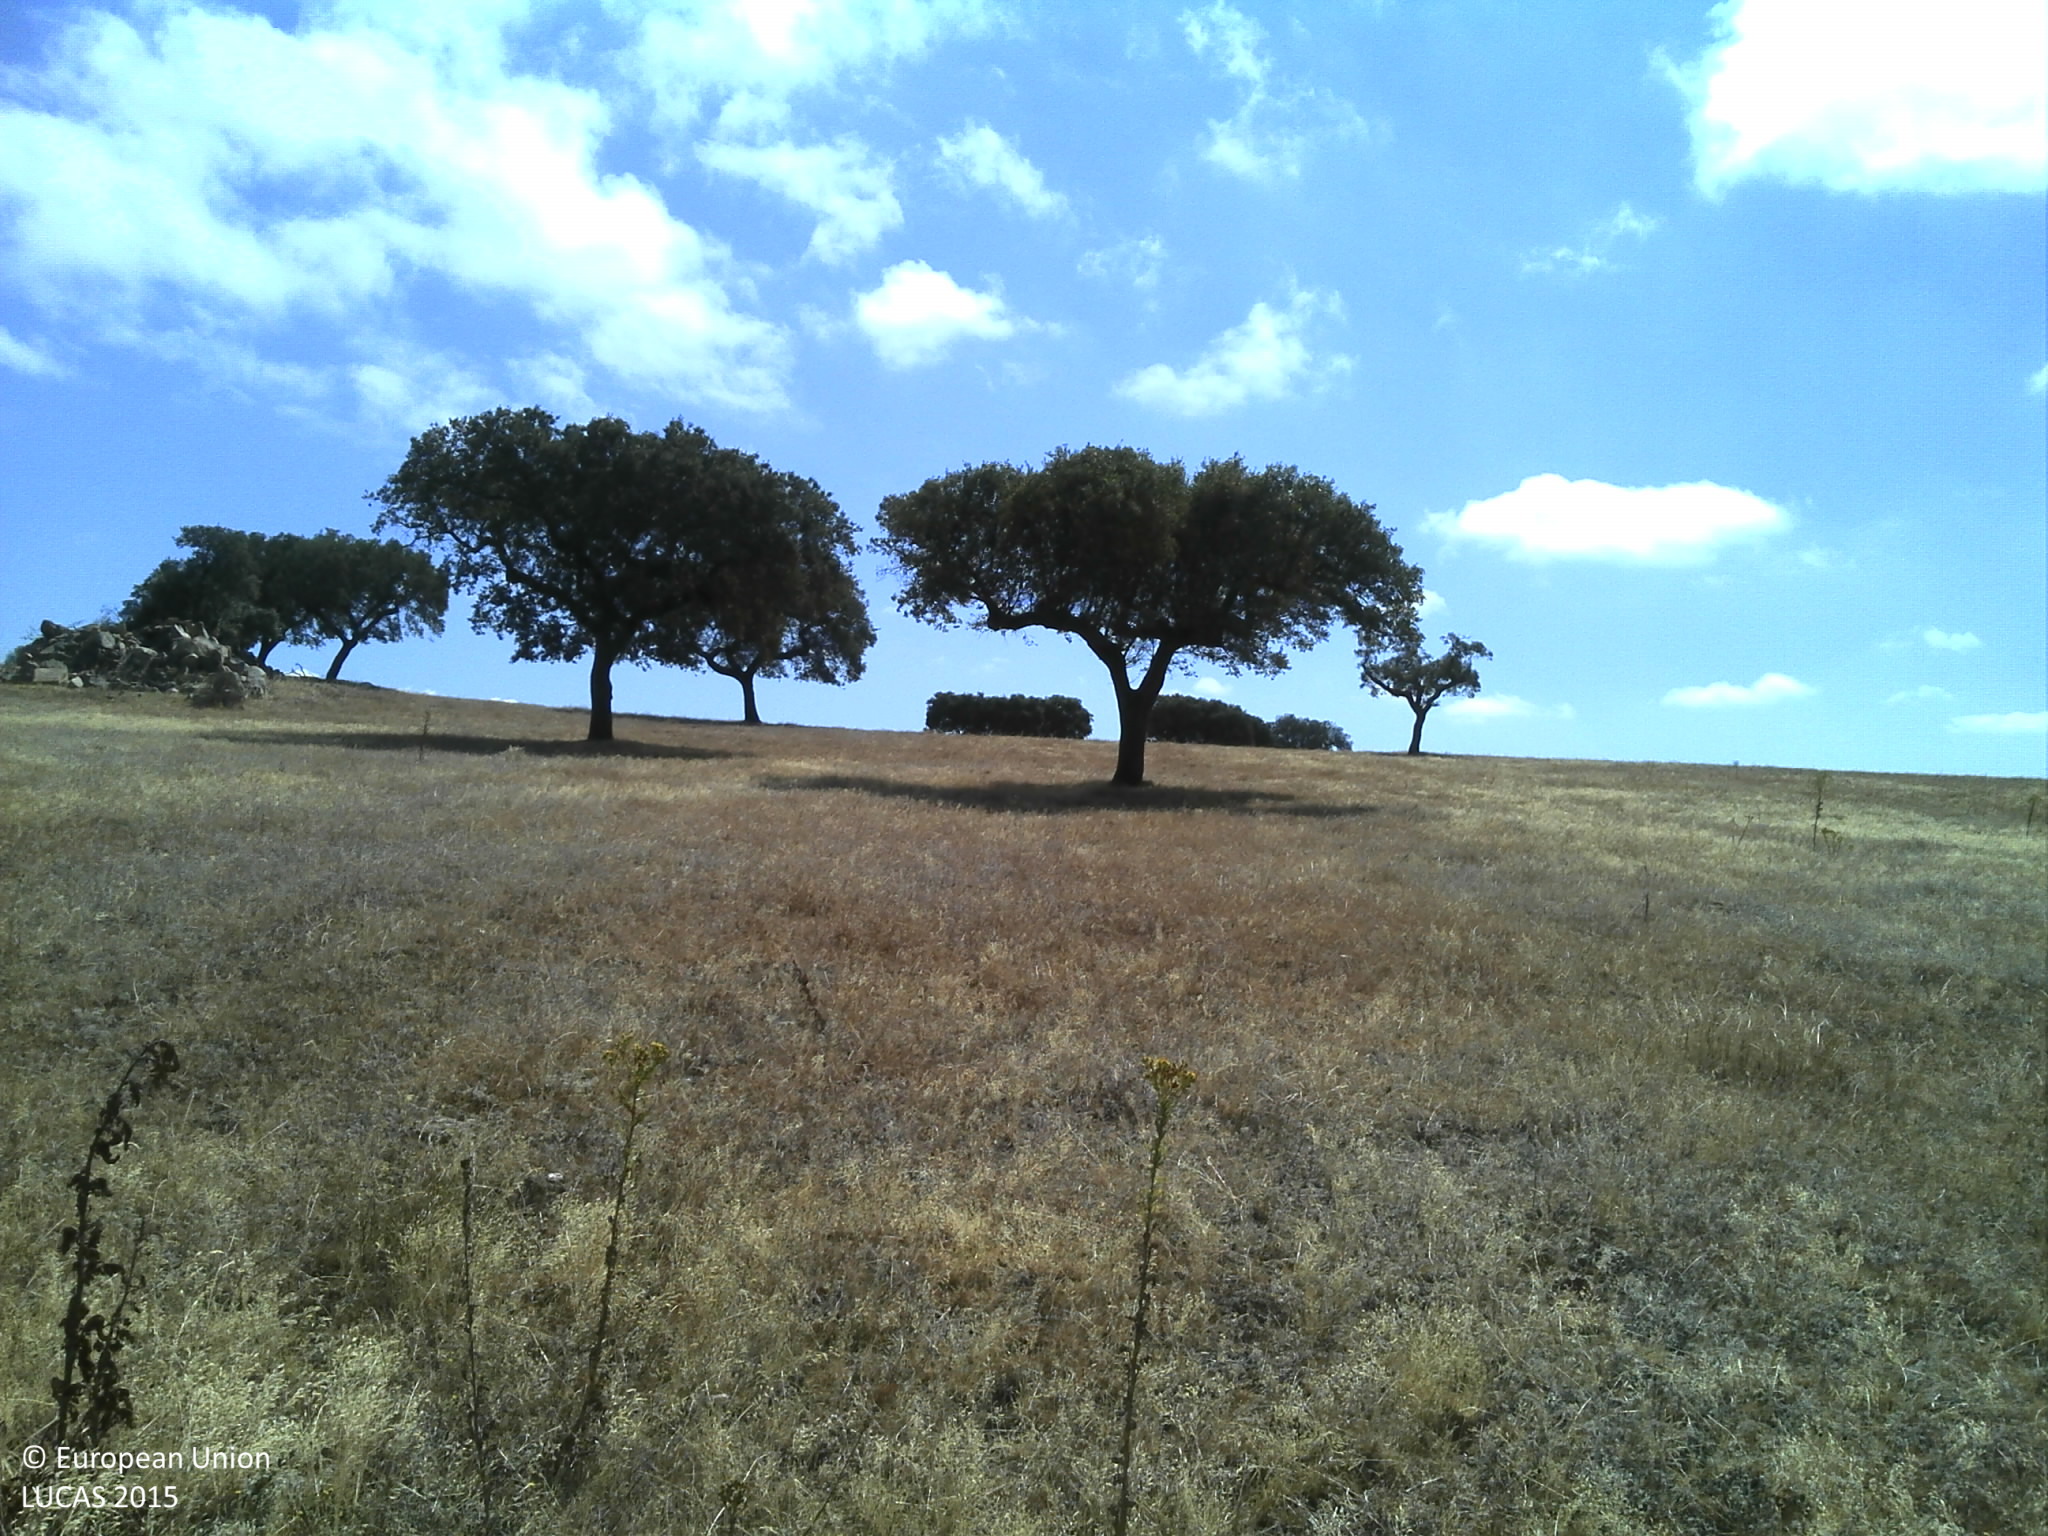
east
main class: Grassland
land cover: Spontaneously vegetated surfaces
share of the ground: 25 - 50 %
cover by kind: unconsolidated bare surface 70 %, herbaceous plants 30 %
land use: Agriculture (excluding fallow land and kitchen gardens)
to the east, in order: Spontaneously vegetated surfaces; Grassland with sparse tree/shrub cover; Spontaneously vegetated surfaces; Rocks and stones; Spontaneously vegetated surfaces
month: July
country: PT
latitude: 39.2063
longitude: -7.3507
